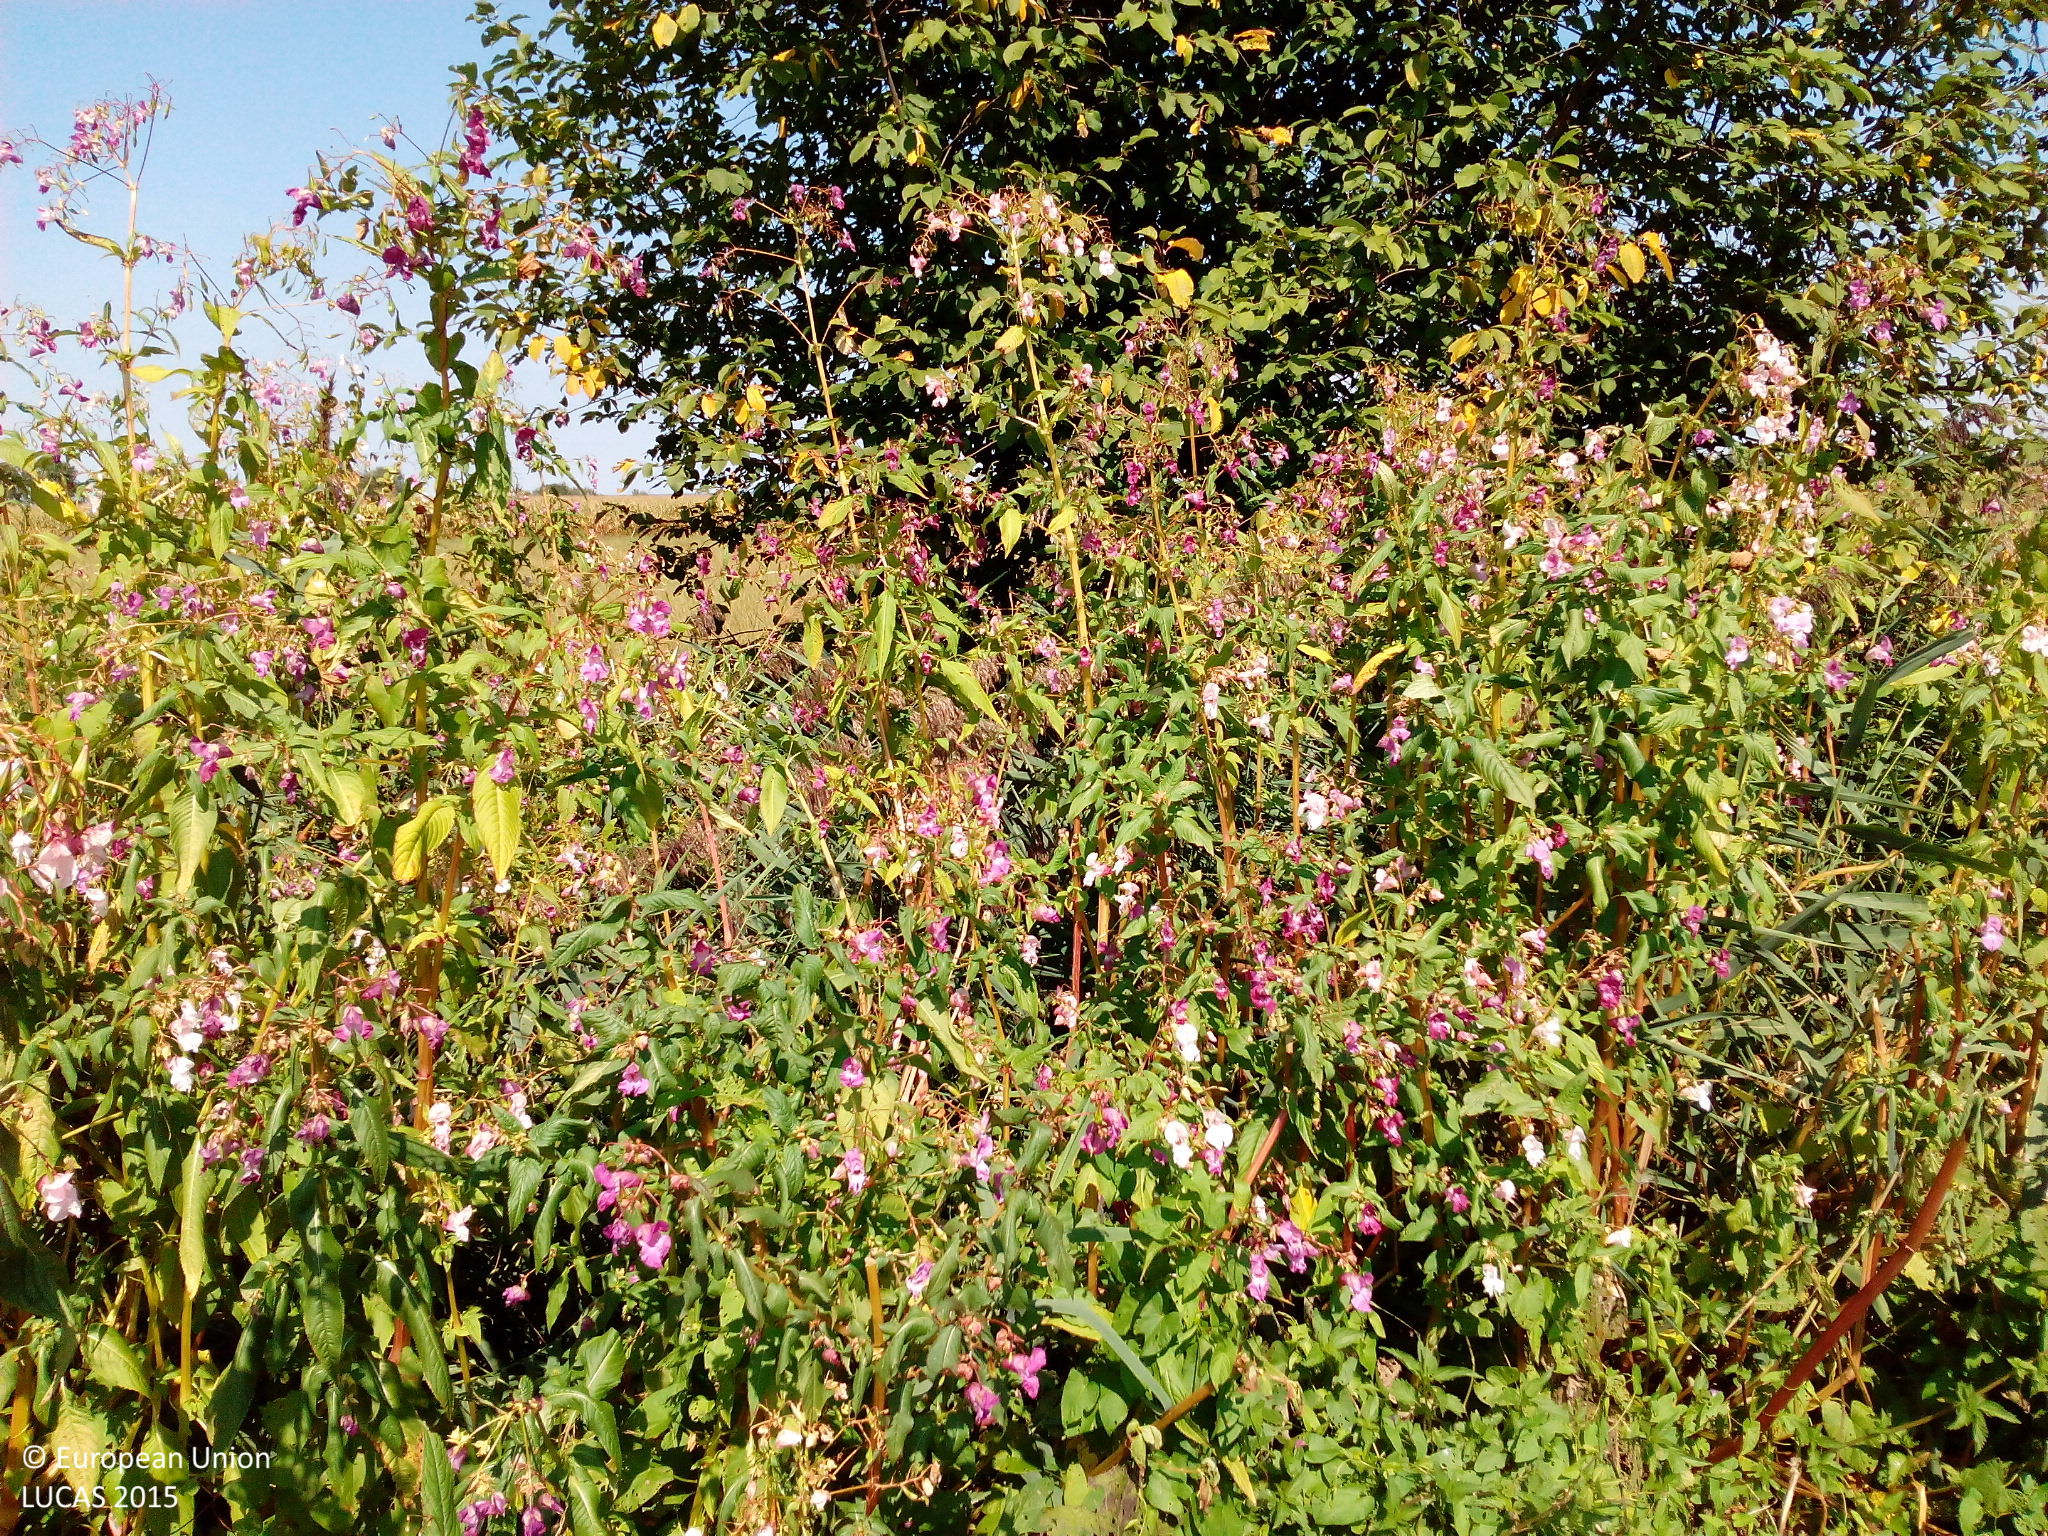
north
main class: Grassland
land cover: Grassland without tree/shrub cover
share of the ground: > 75 %
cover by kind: herbaceous plants 95 %, unconsolidated bare surface 5 %
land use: Agriculture (excluding fallow land and kitchen gardens)
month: August
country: DE
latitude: 48.4931
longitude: 10.2570
